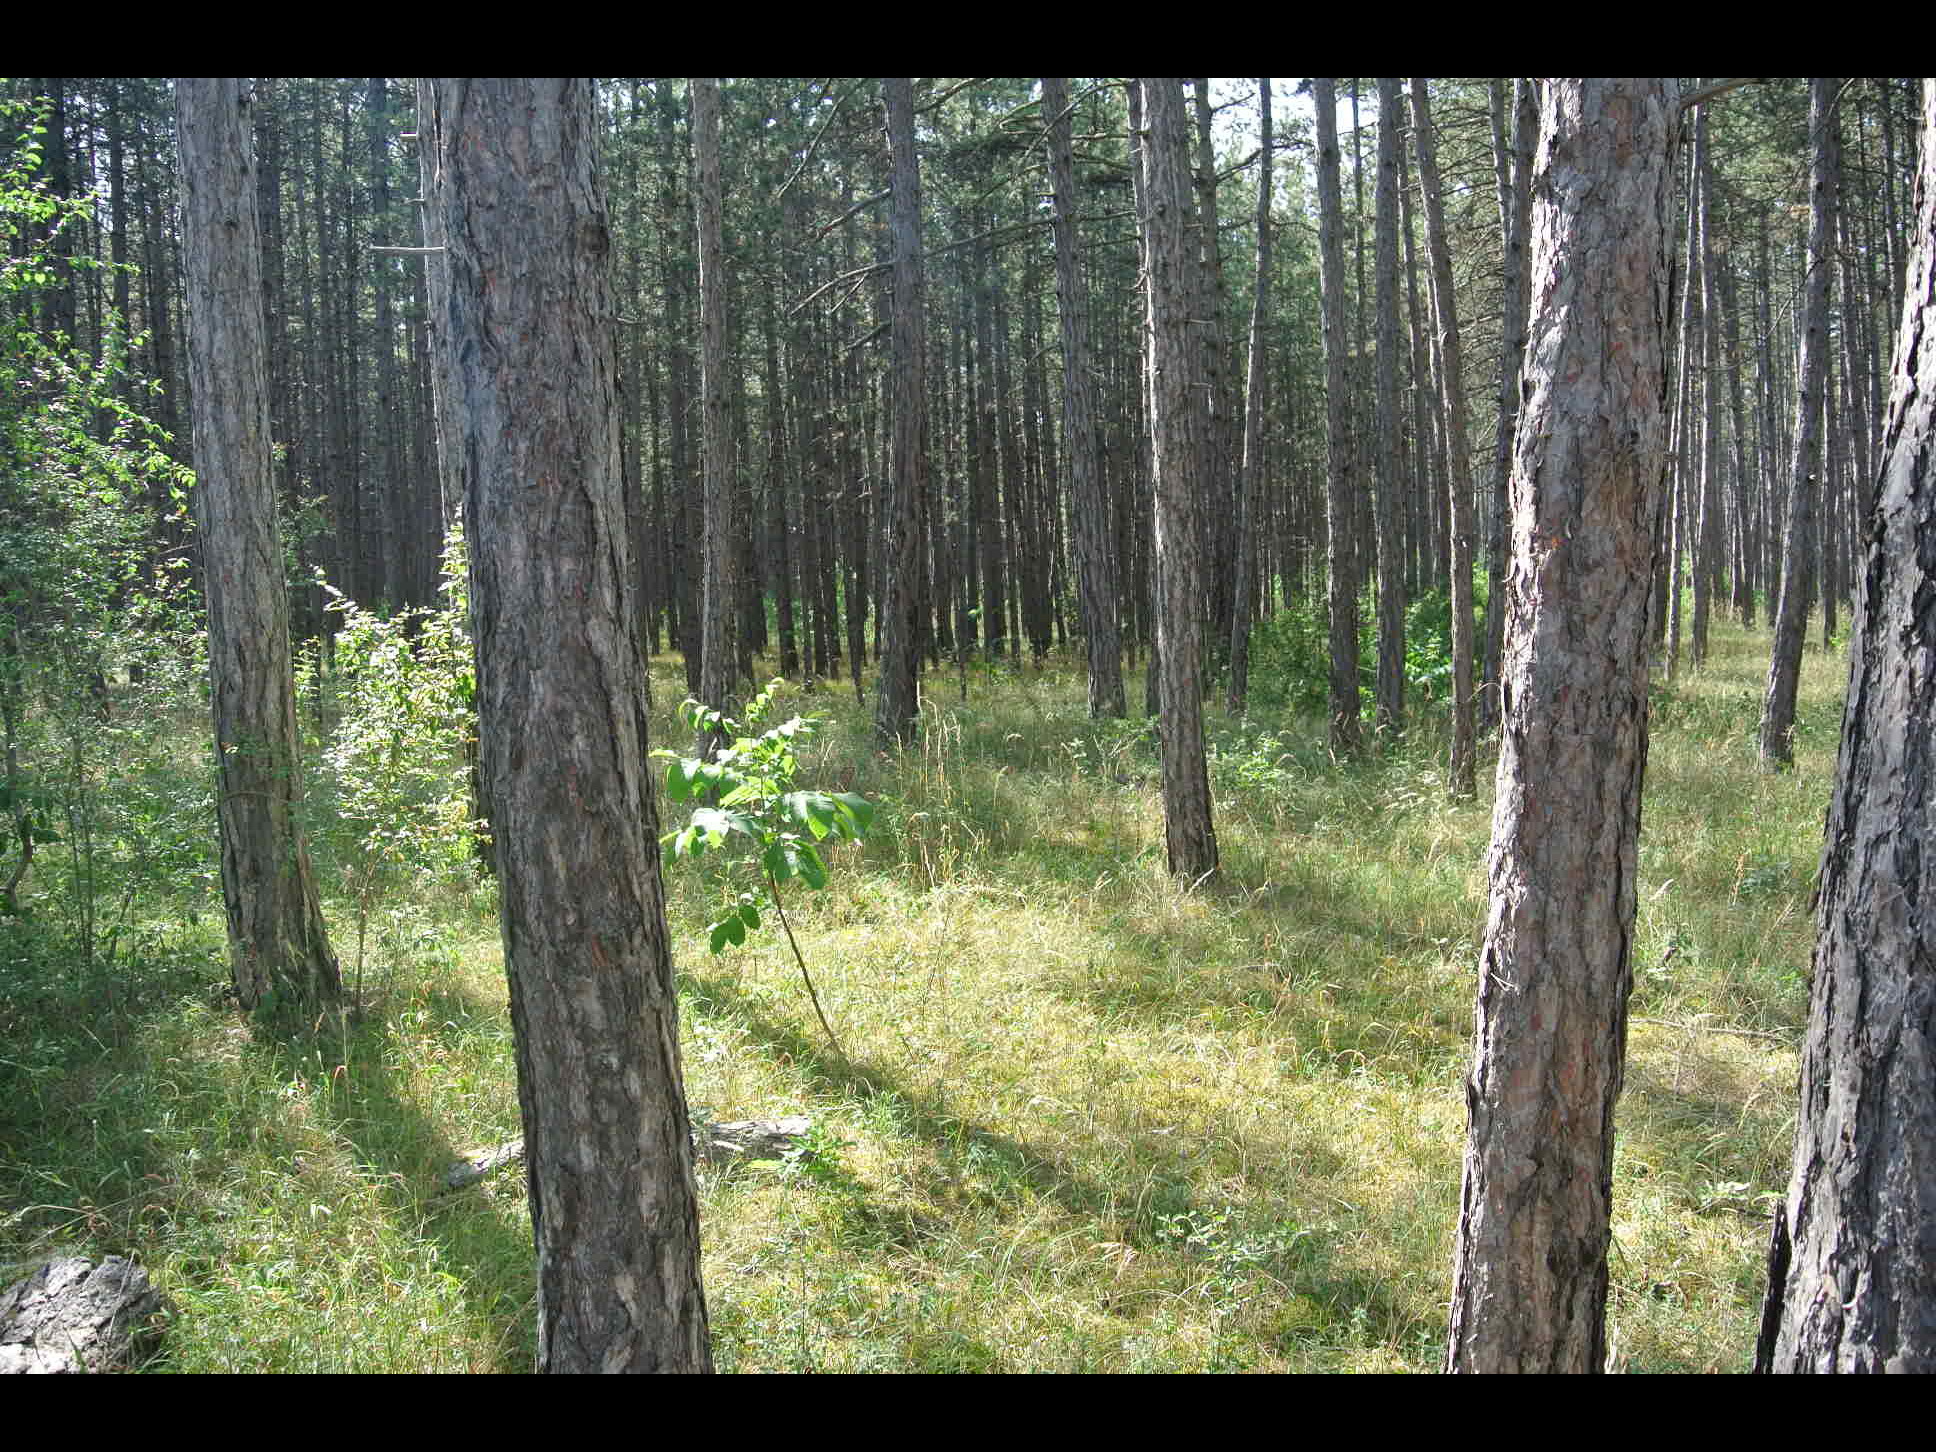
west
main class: Woodland
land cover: Pine dominated coniferous woodland
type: alpine coniferous forest
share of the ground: > 75 %
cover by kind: coniferous forest trees 90 %, herbaceous plants 10 %
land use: Forestry
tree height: > 5 m
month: July
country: AT
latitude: 47.7793
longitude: 16.1826
